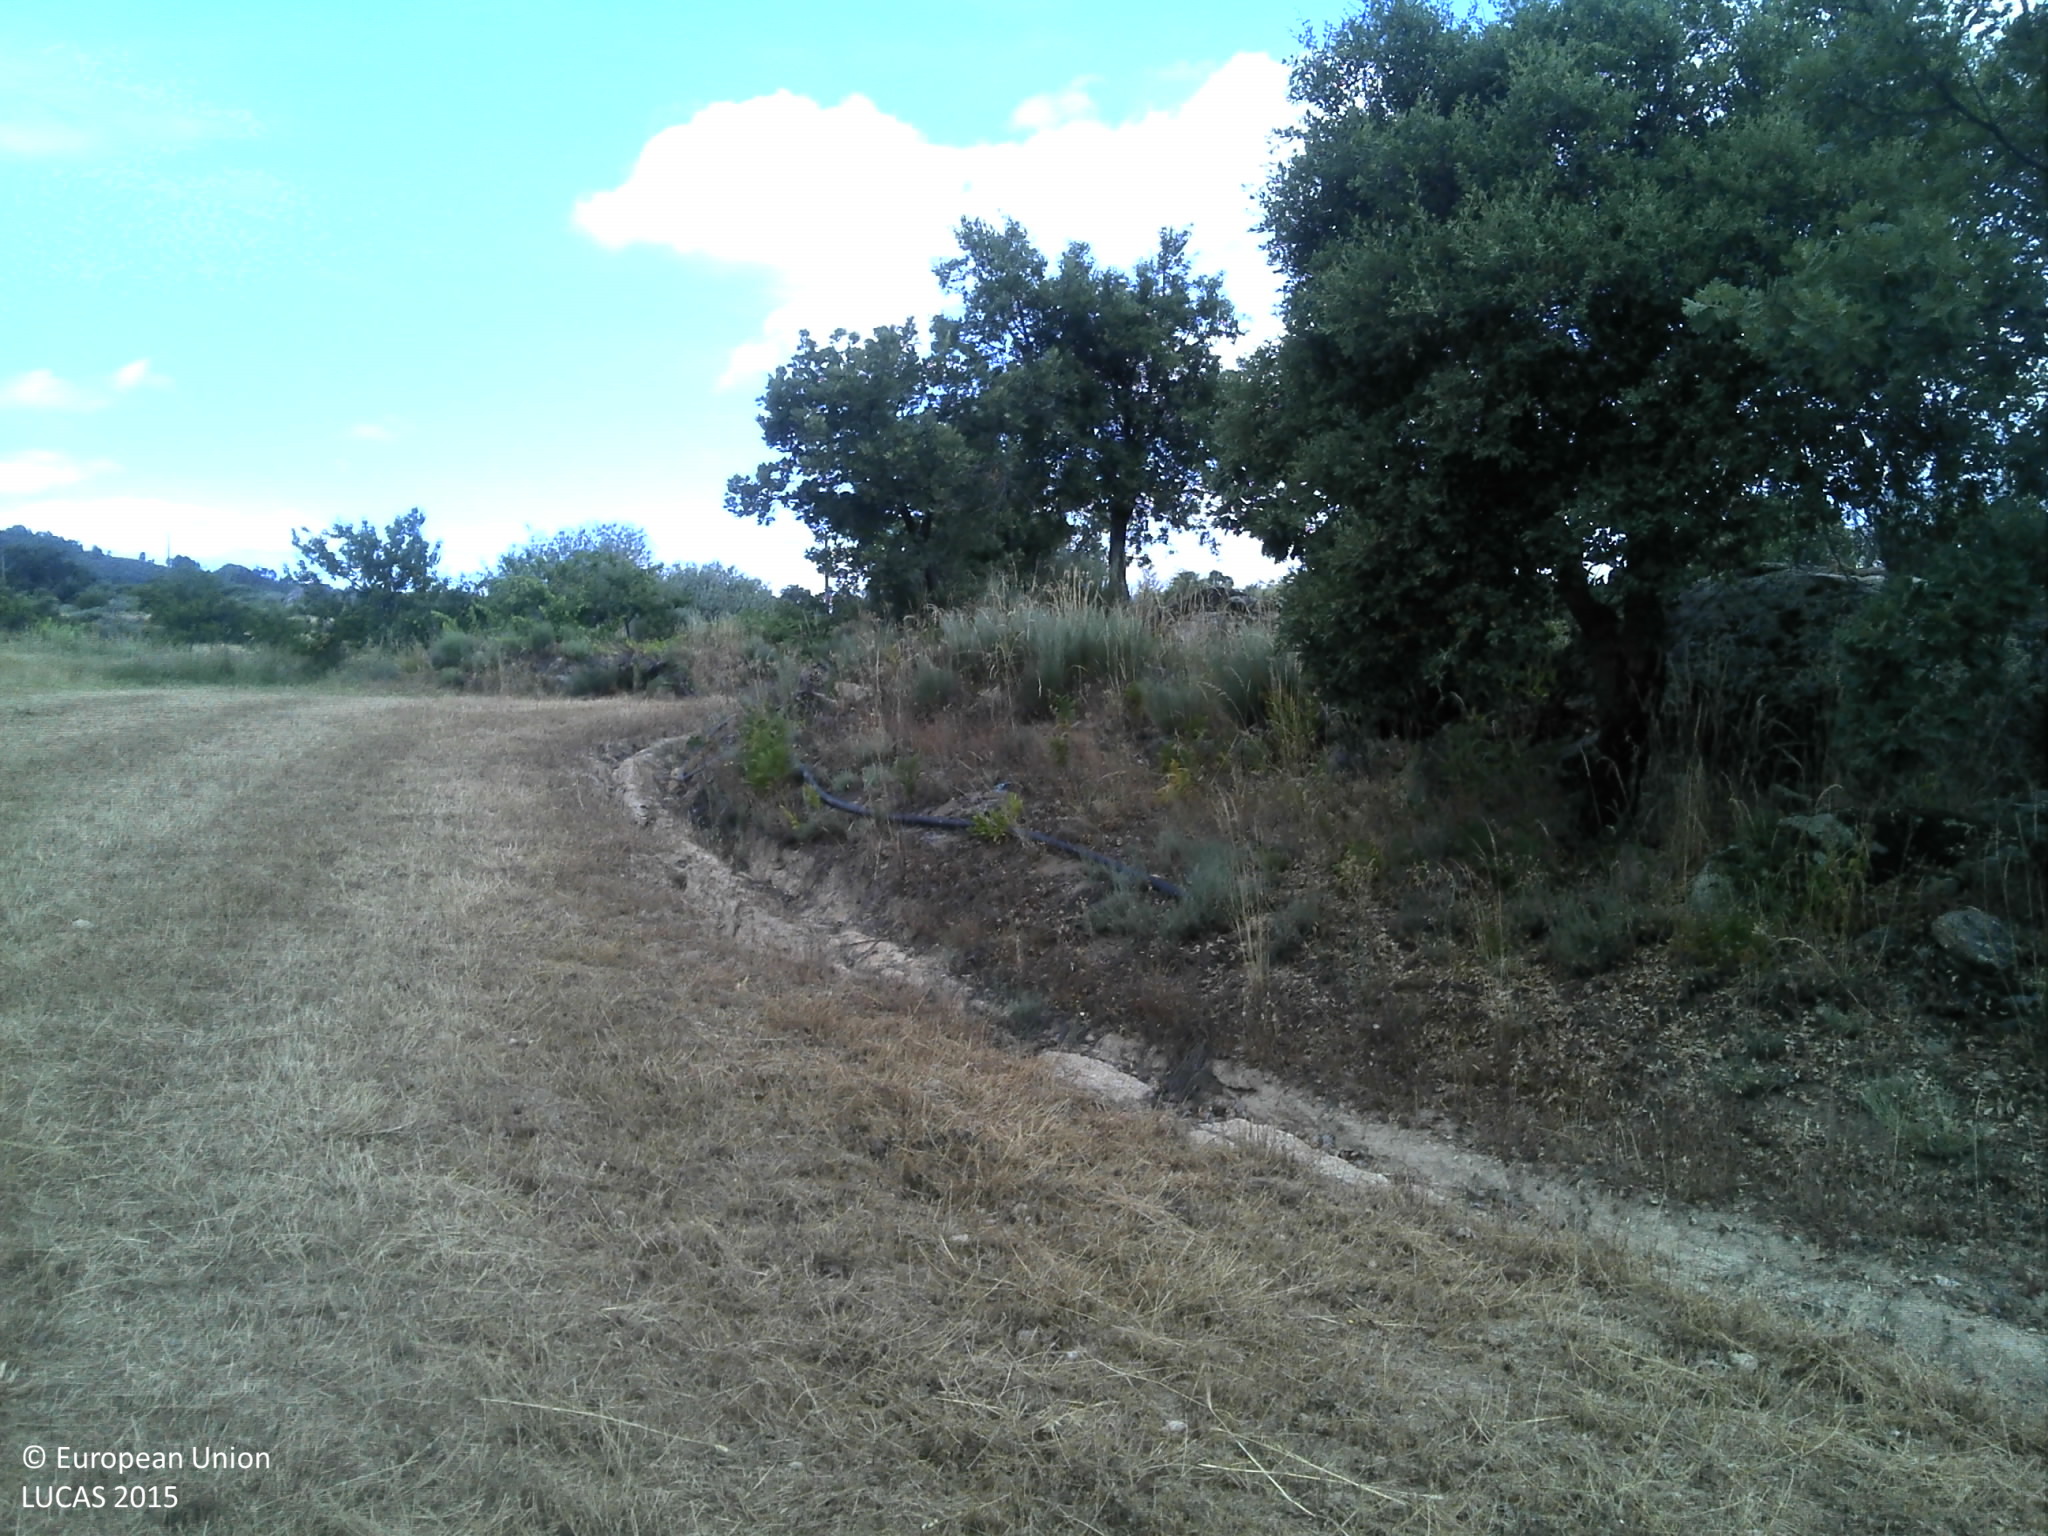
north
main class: Cropland
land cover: Olive groves
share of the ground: 10 - 25 %
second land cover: Spontaneously vegetated surfaces
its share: < 10 %
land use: Agriculture (excluding fallow land and kitchen gardens)
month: June
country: PT
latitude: 40.1348
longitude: -7.3175
